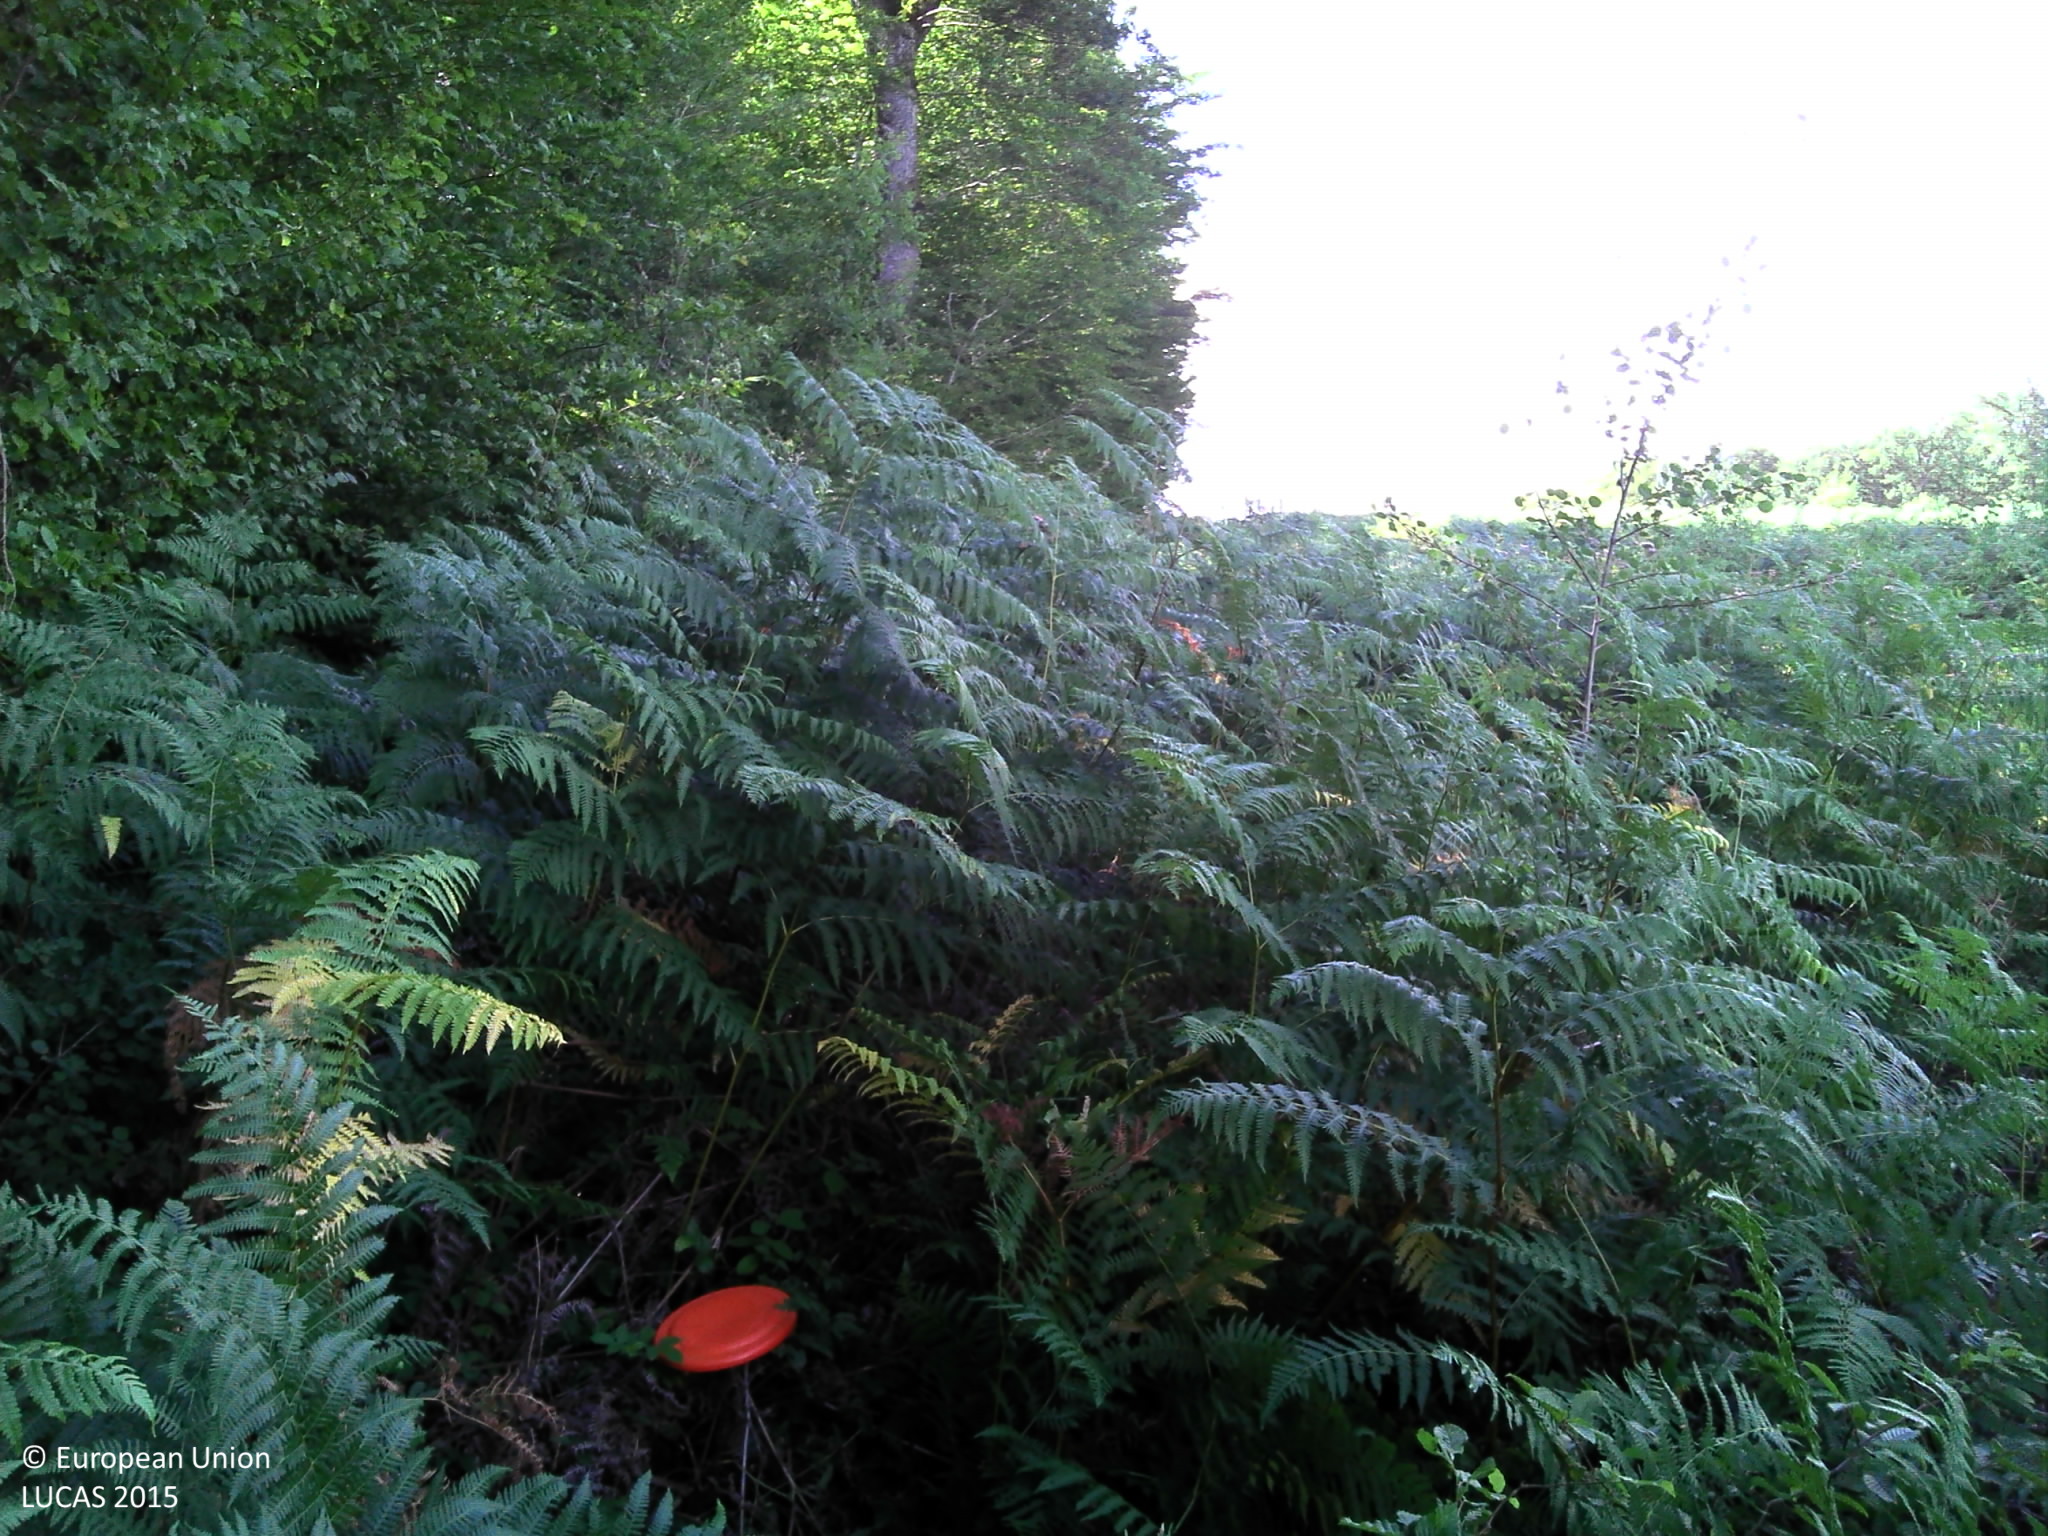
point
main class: Shrubland
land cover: Shrubland with sparse tree cover
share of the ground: > 75 %
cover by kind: herbaceous plants 80 %, shrubs 15 %, broadleaved forest trees 5 %
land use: Semi-natural and natural areas not in use
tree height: < 5 m
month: July
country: FR
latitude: 48.0279
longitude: 3.4373
